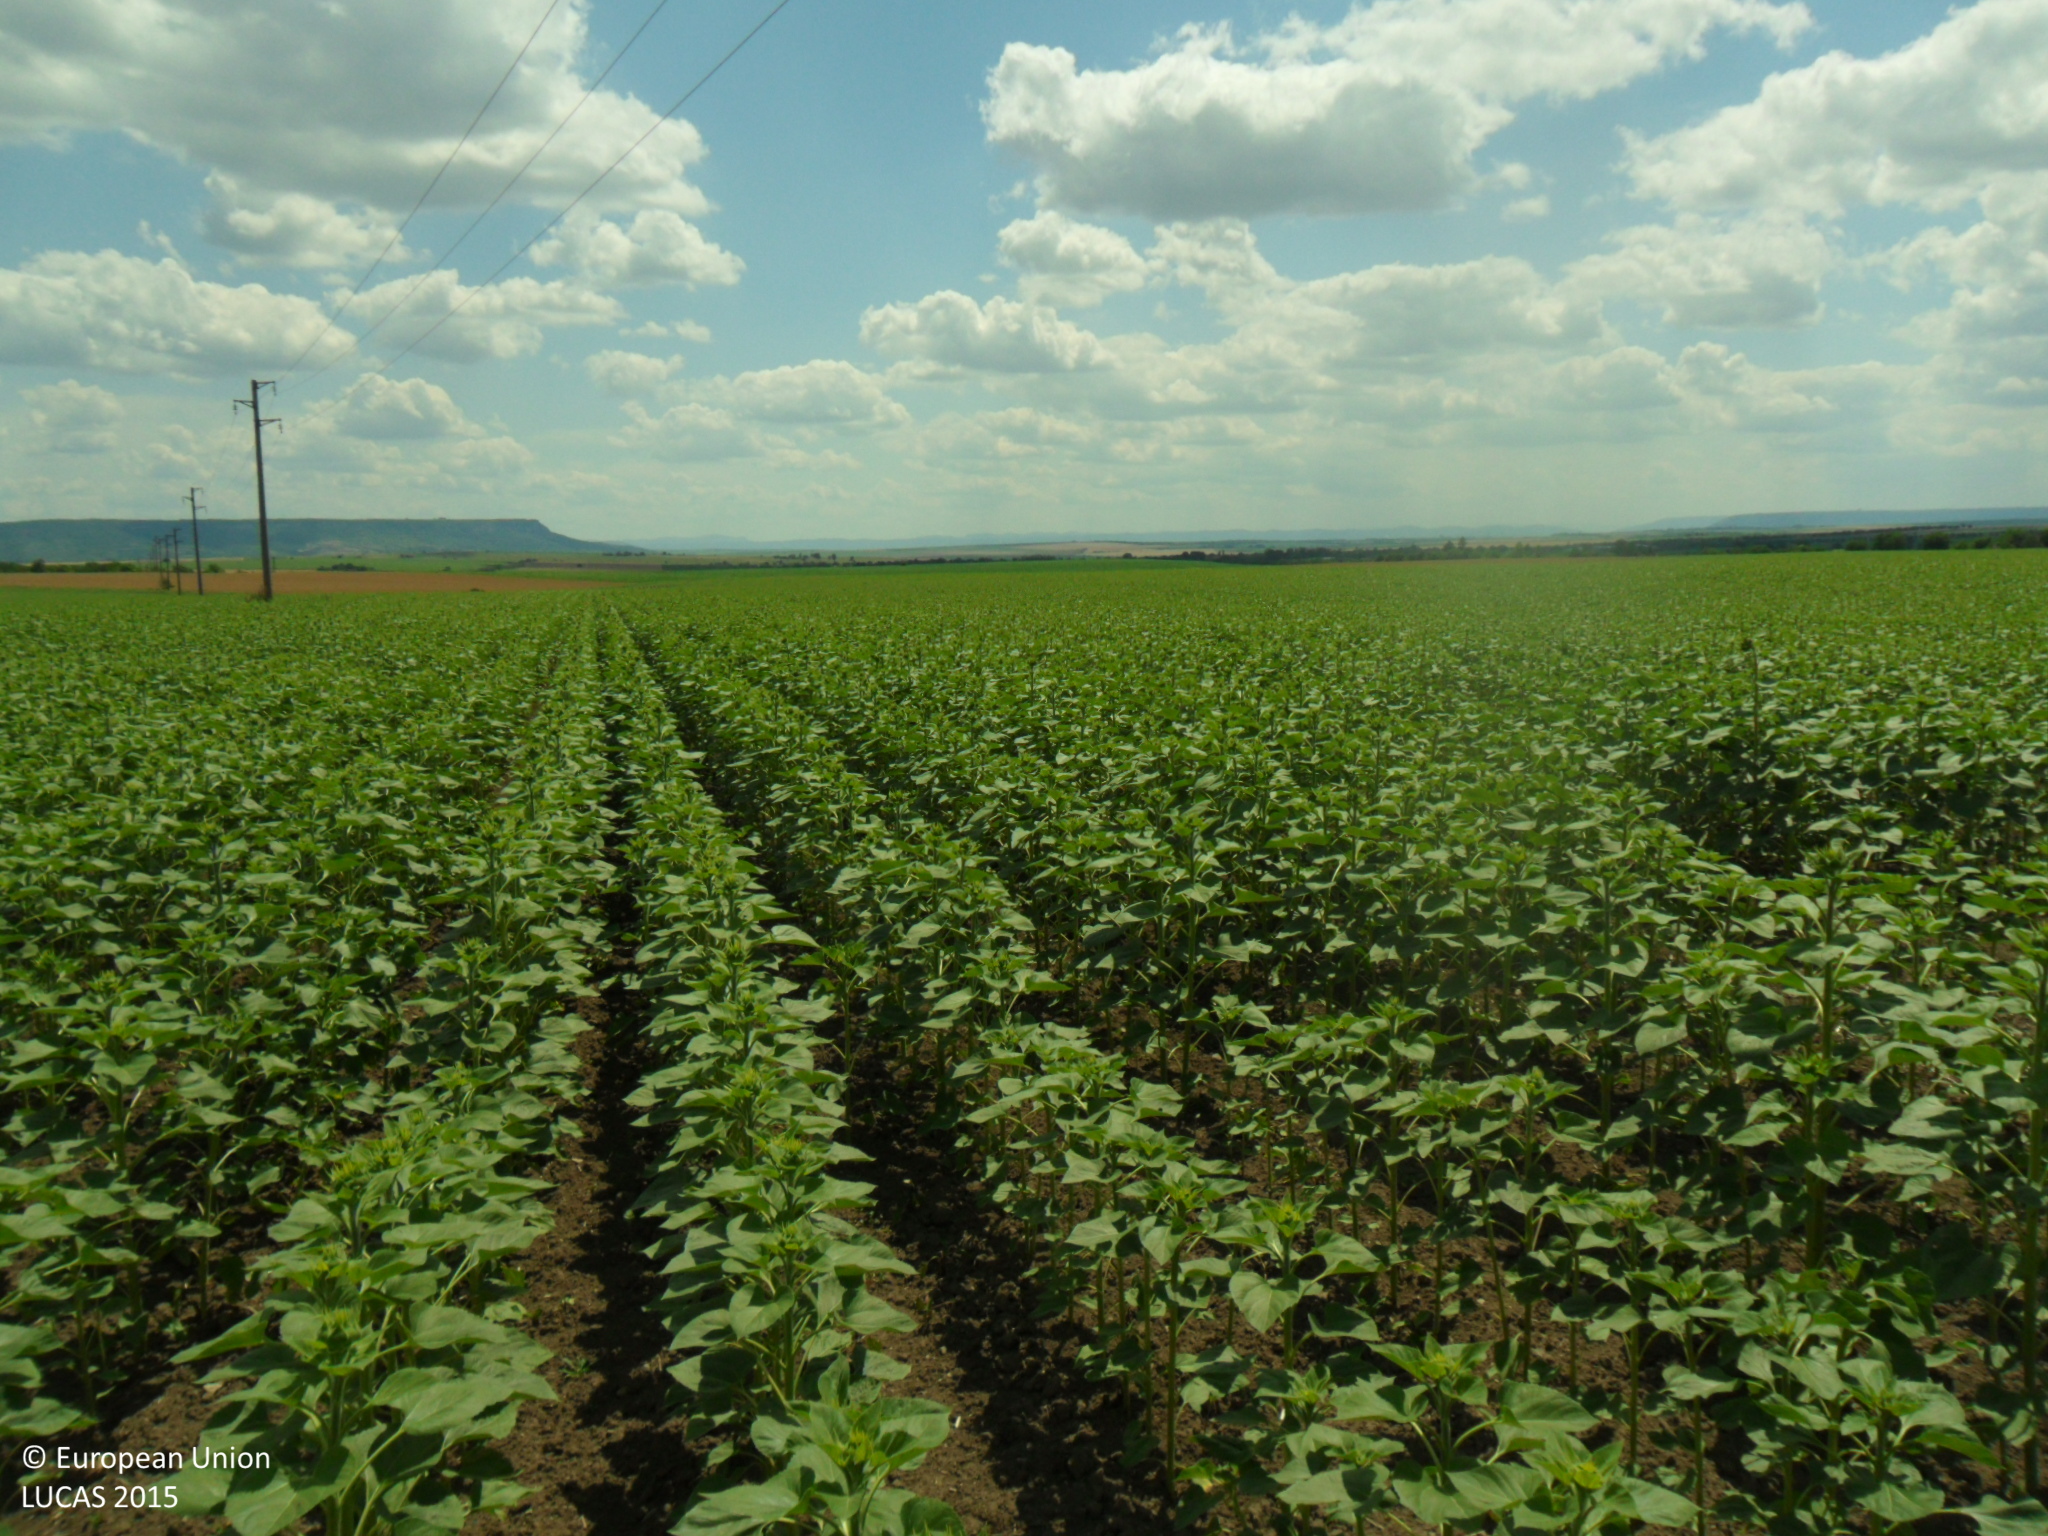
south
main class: Cropland
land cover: Sunflower
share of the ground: > 75 %
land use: Agriculture (excluding fallow land and kitchen gardens)
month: June
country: BG
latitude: 43.3894
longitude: 27.1436
